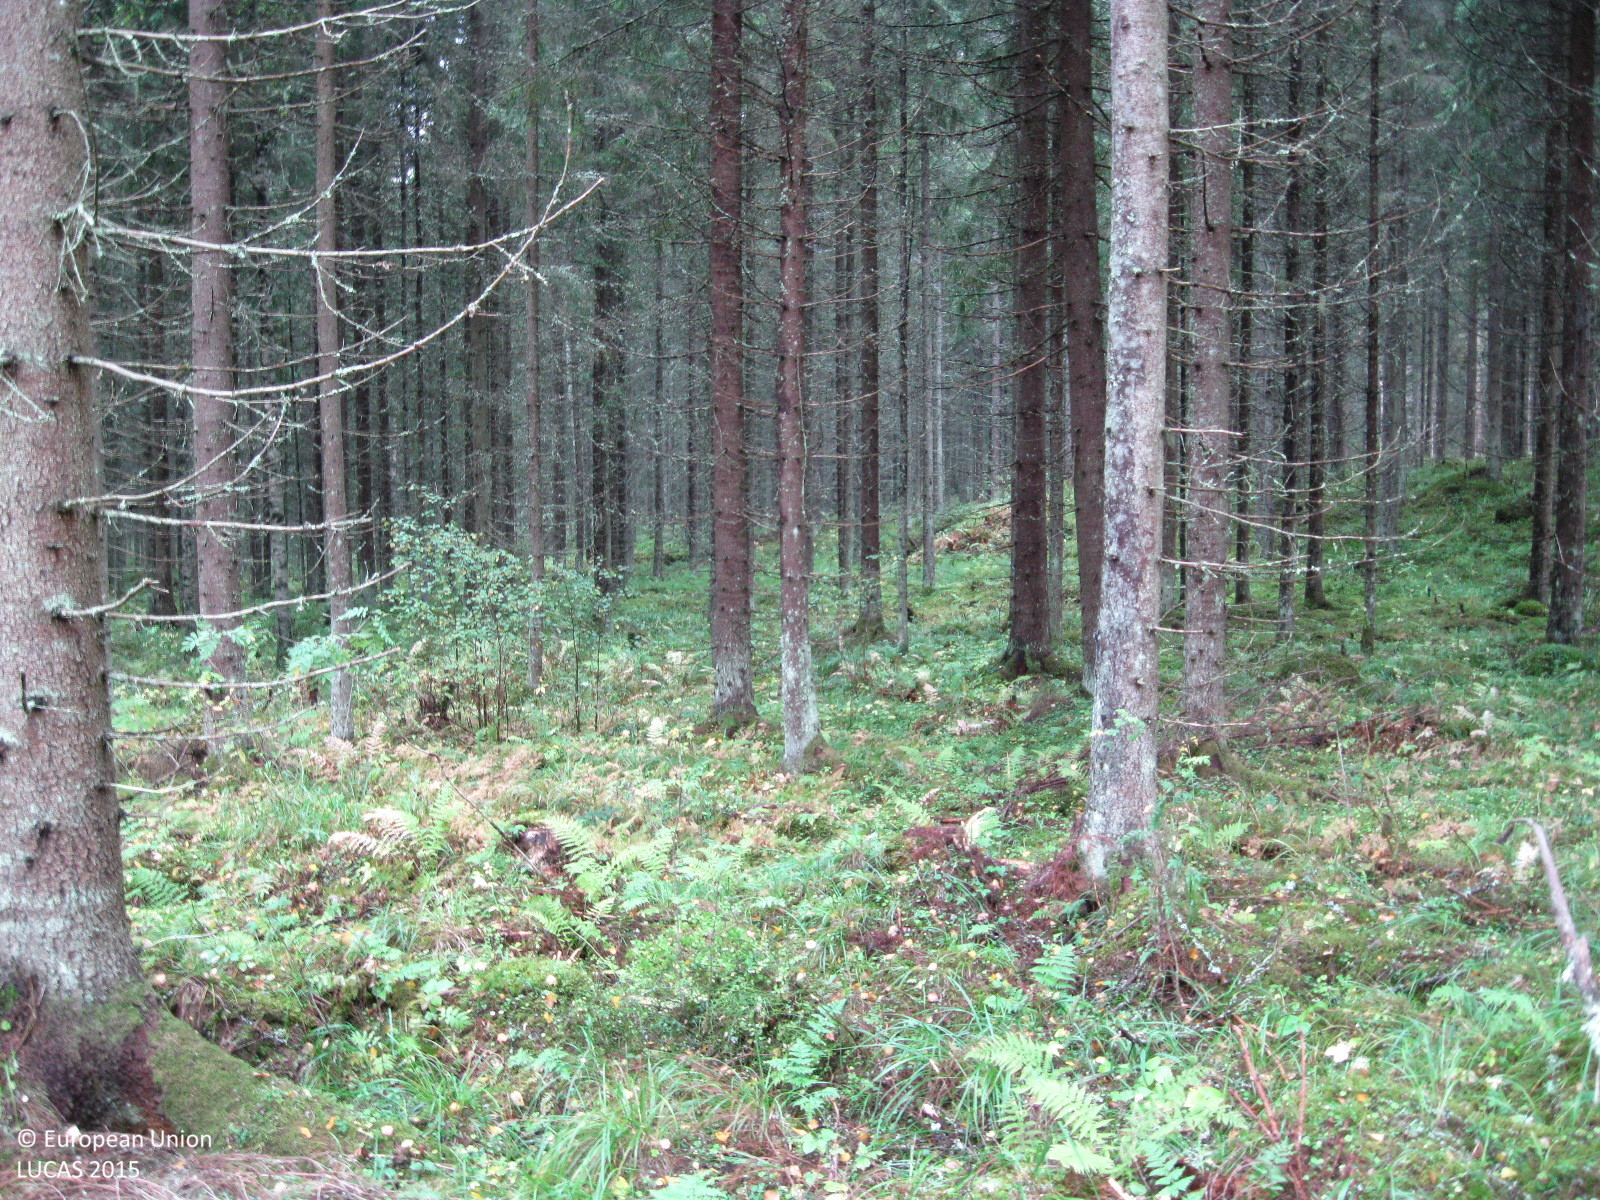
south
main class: Grassland
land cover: Spontaneously vegetated surfaces
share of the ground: > 75 %
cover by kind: herbaceous plants 100 %
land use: Forestry
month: September
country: FI
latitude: 60.9063
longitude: 24.9170
